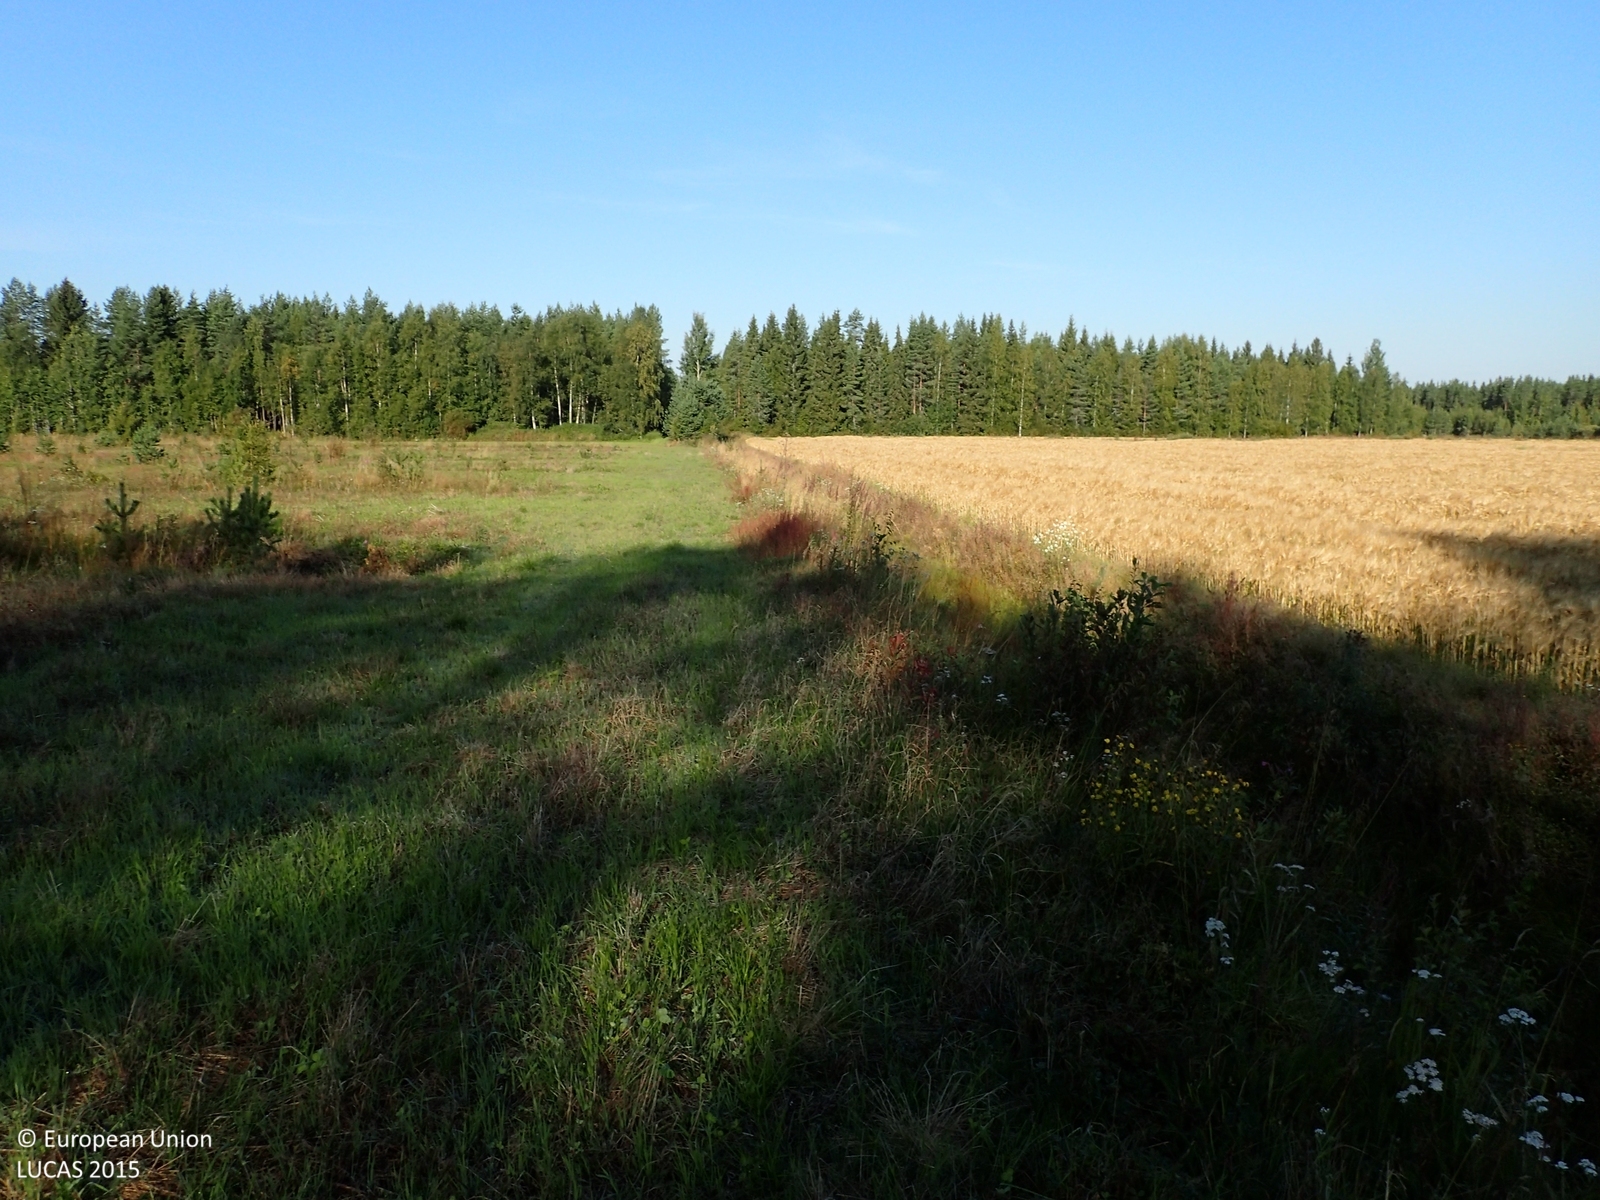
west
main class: Cropland
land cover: Temporary grasslands
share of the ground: > 75 %
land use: Agriculture (excluding fallow land and kitchen gardens)
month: August
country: FI
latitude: 62.4617
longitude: 21.9726
